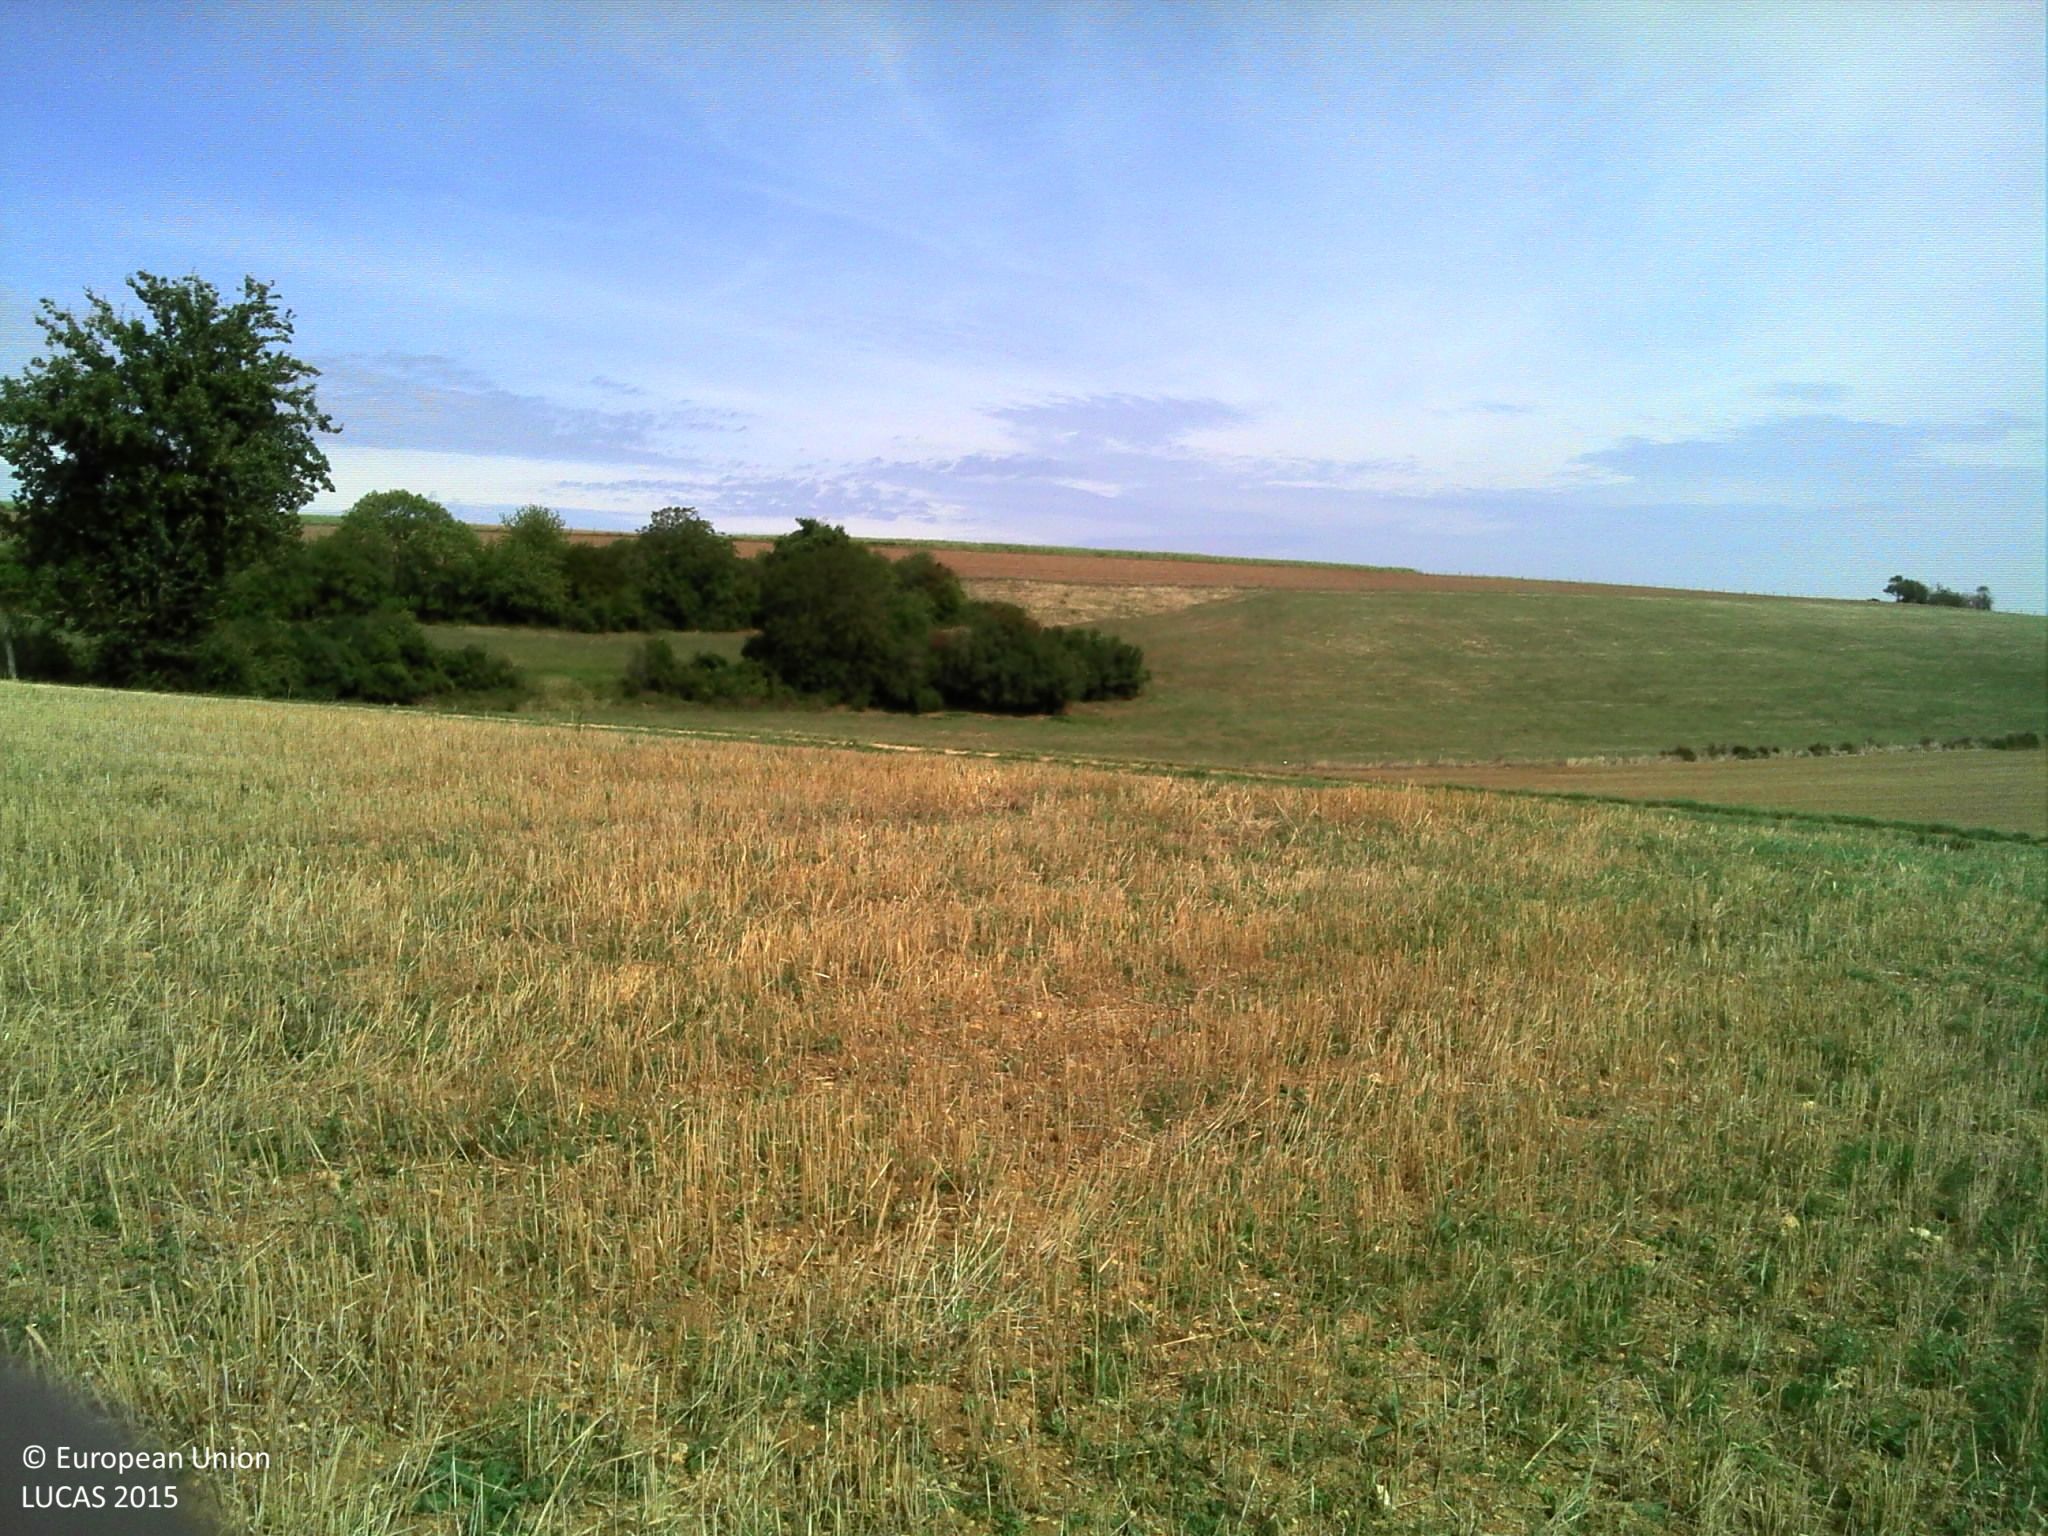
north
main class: Cropland
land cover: Oats
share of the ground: > 75 %
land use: Agriculture (excluding fallow land and kitchen gardens)
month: August
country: FR
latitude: 47.6572
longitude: 4.9534
